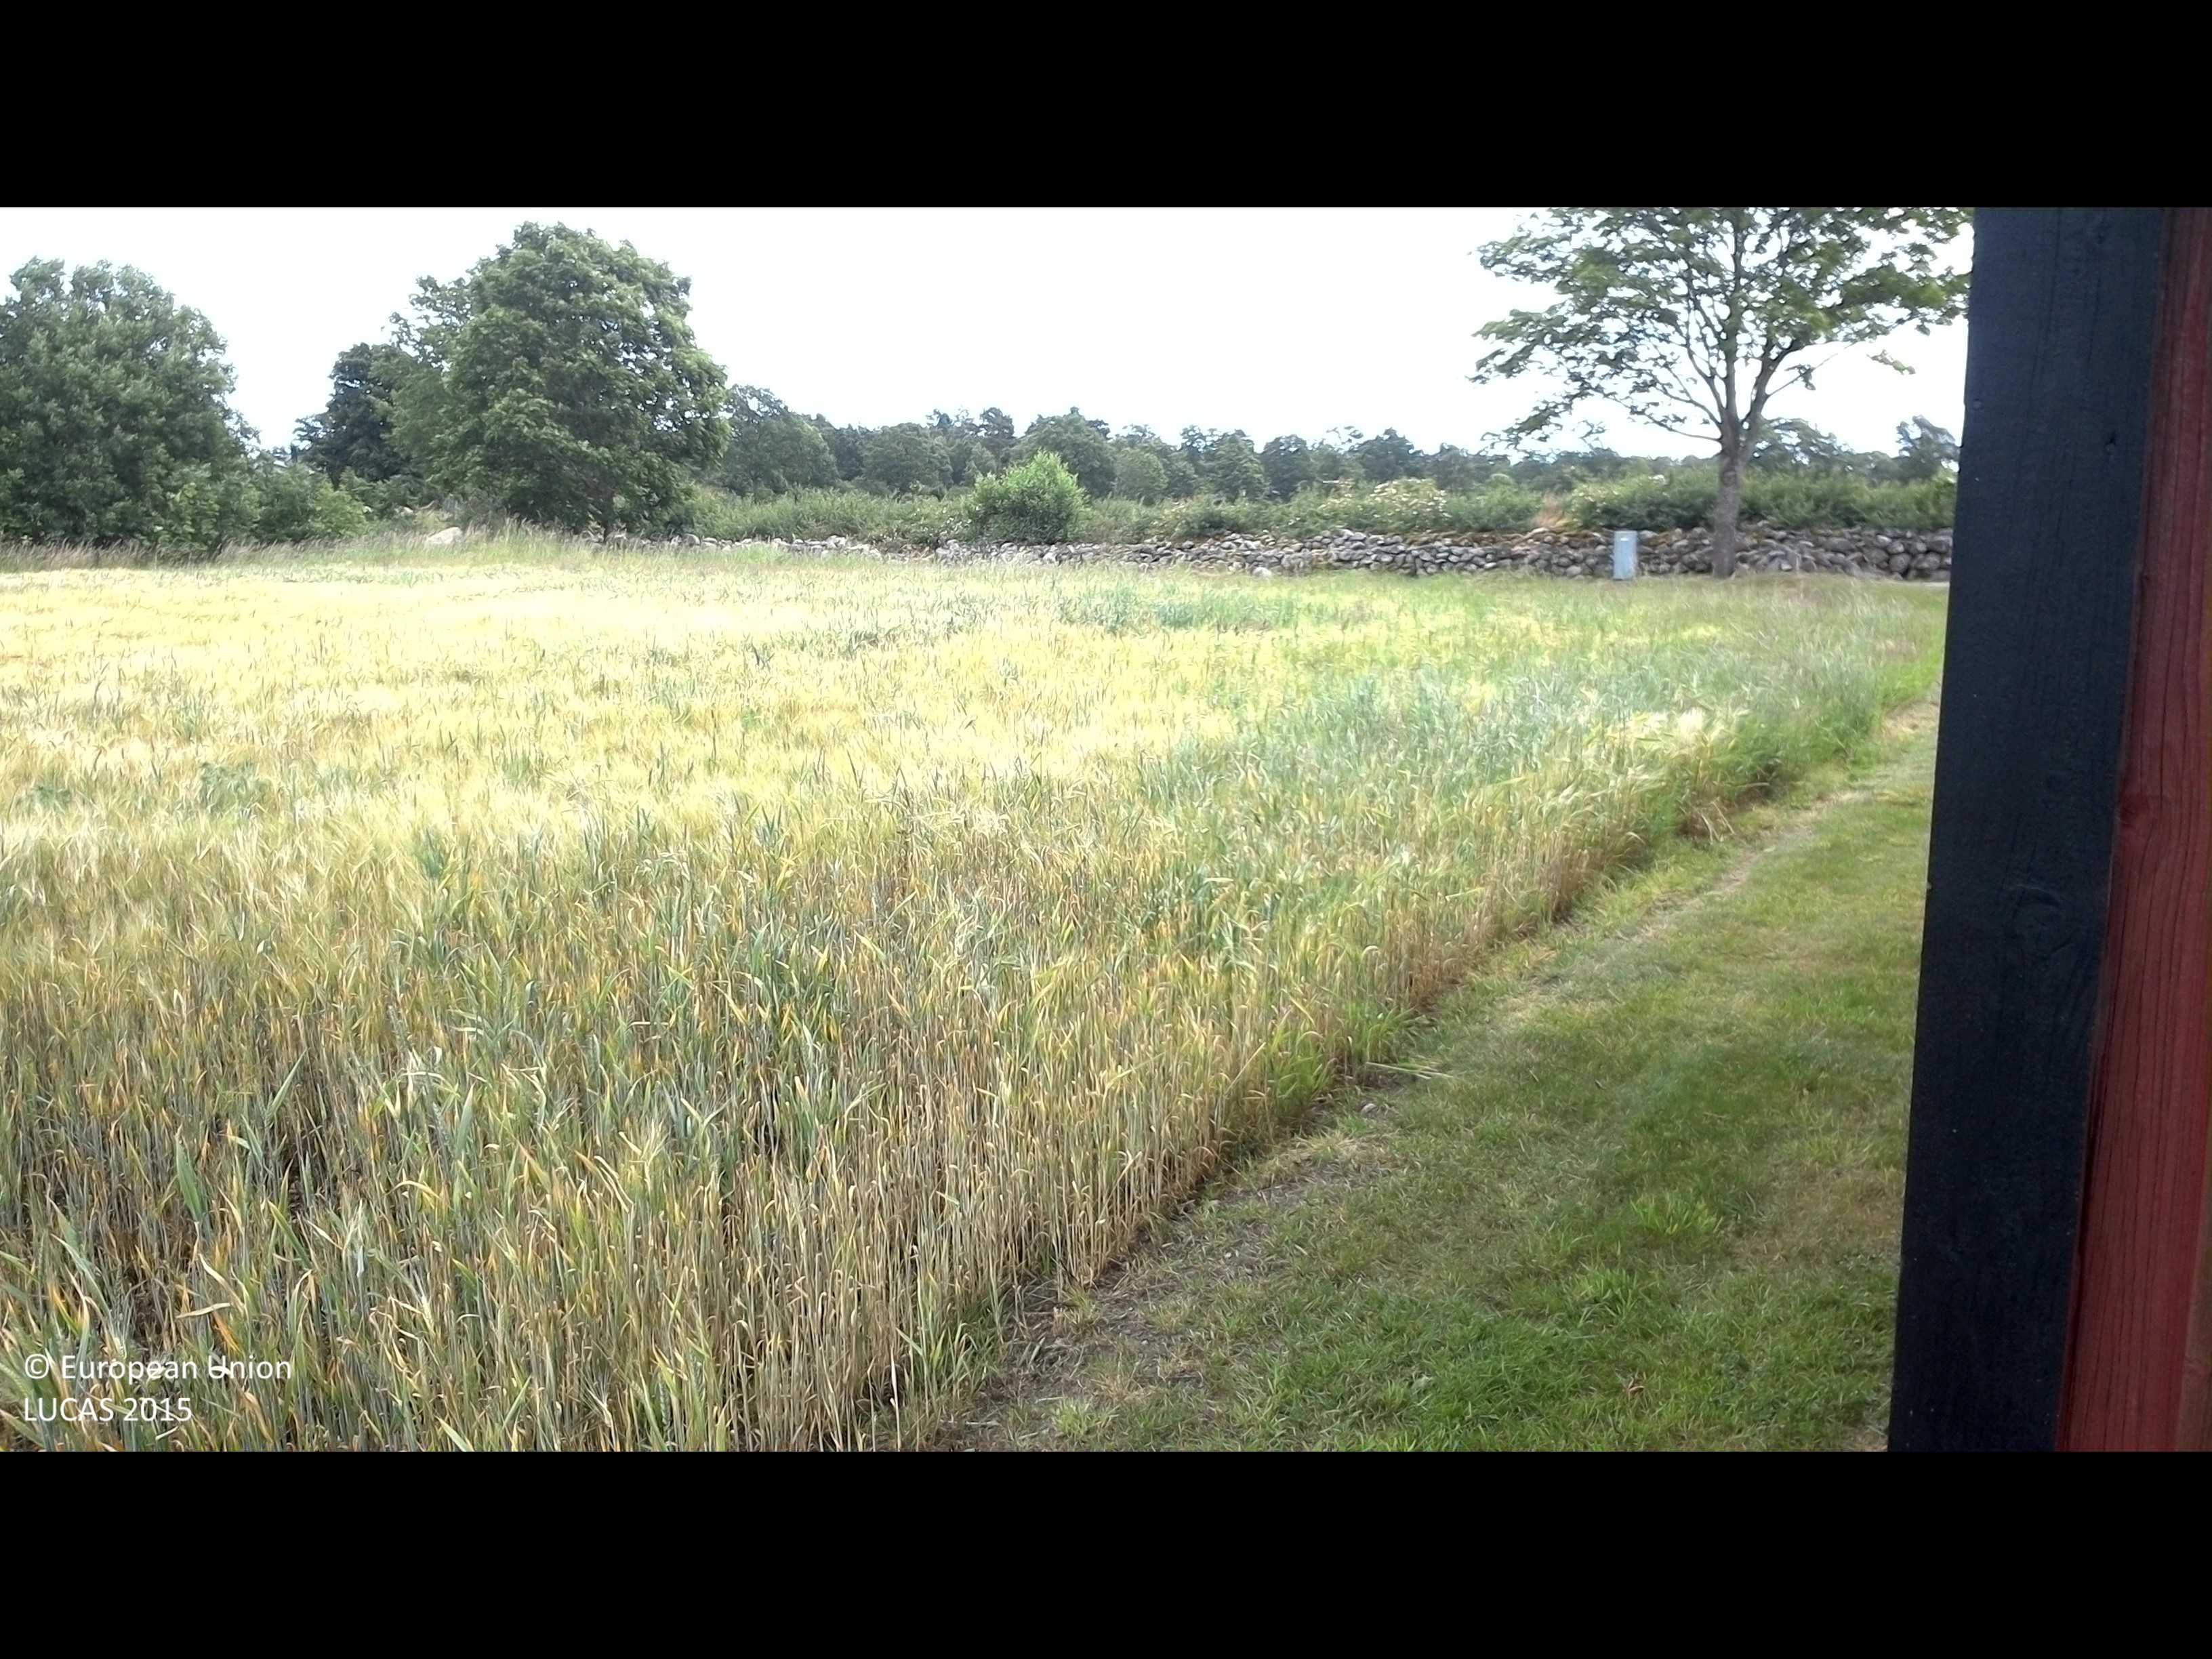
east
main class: Cropland
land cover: Rye
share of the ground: > 75 %
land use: Agriculture (excluding fallow land and kitchen gardens)
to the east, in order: Rye; Grass margins; Dry stone walls; Paved roads, cycling and walking lanes; Dry stone walls; Abandoned hedges; Temporary grasslands
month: June
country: SE
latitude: 56.4567
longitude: 16.1182
